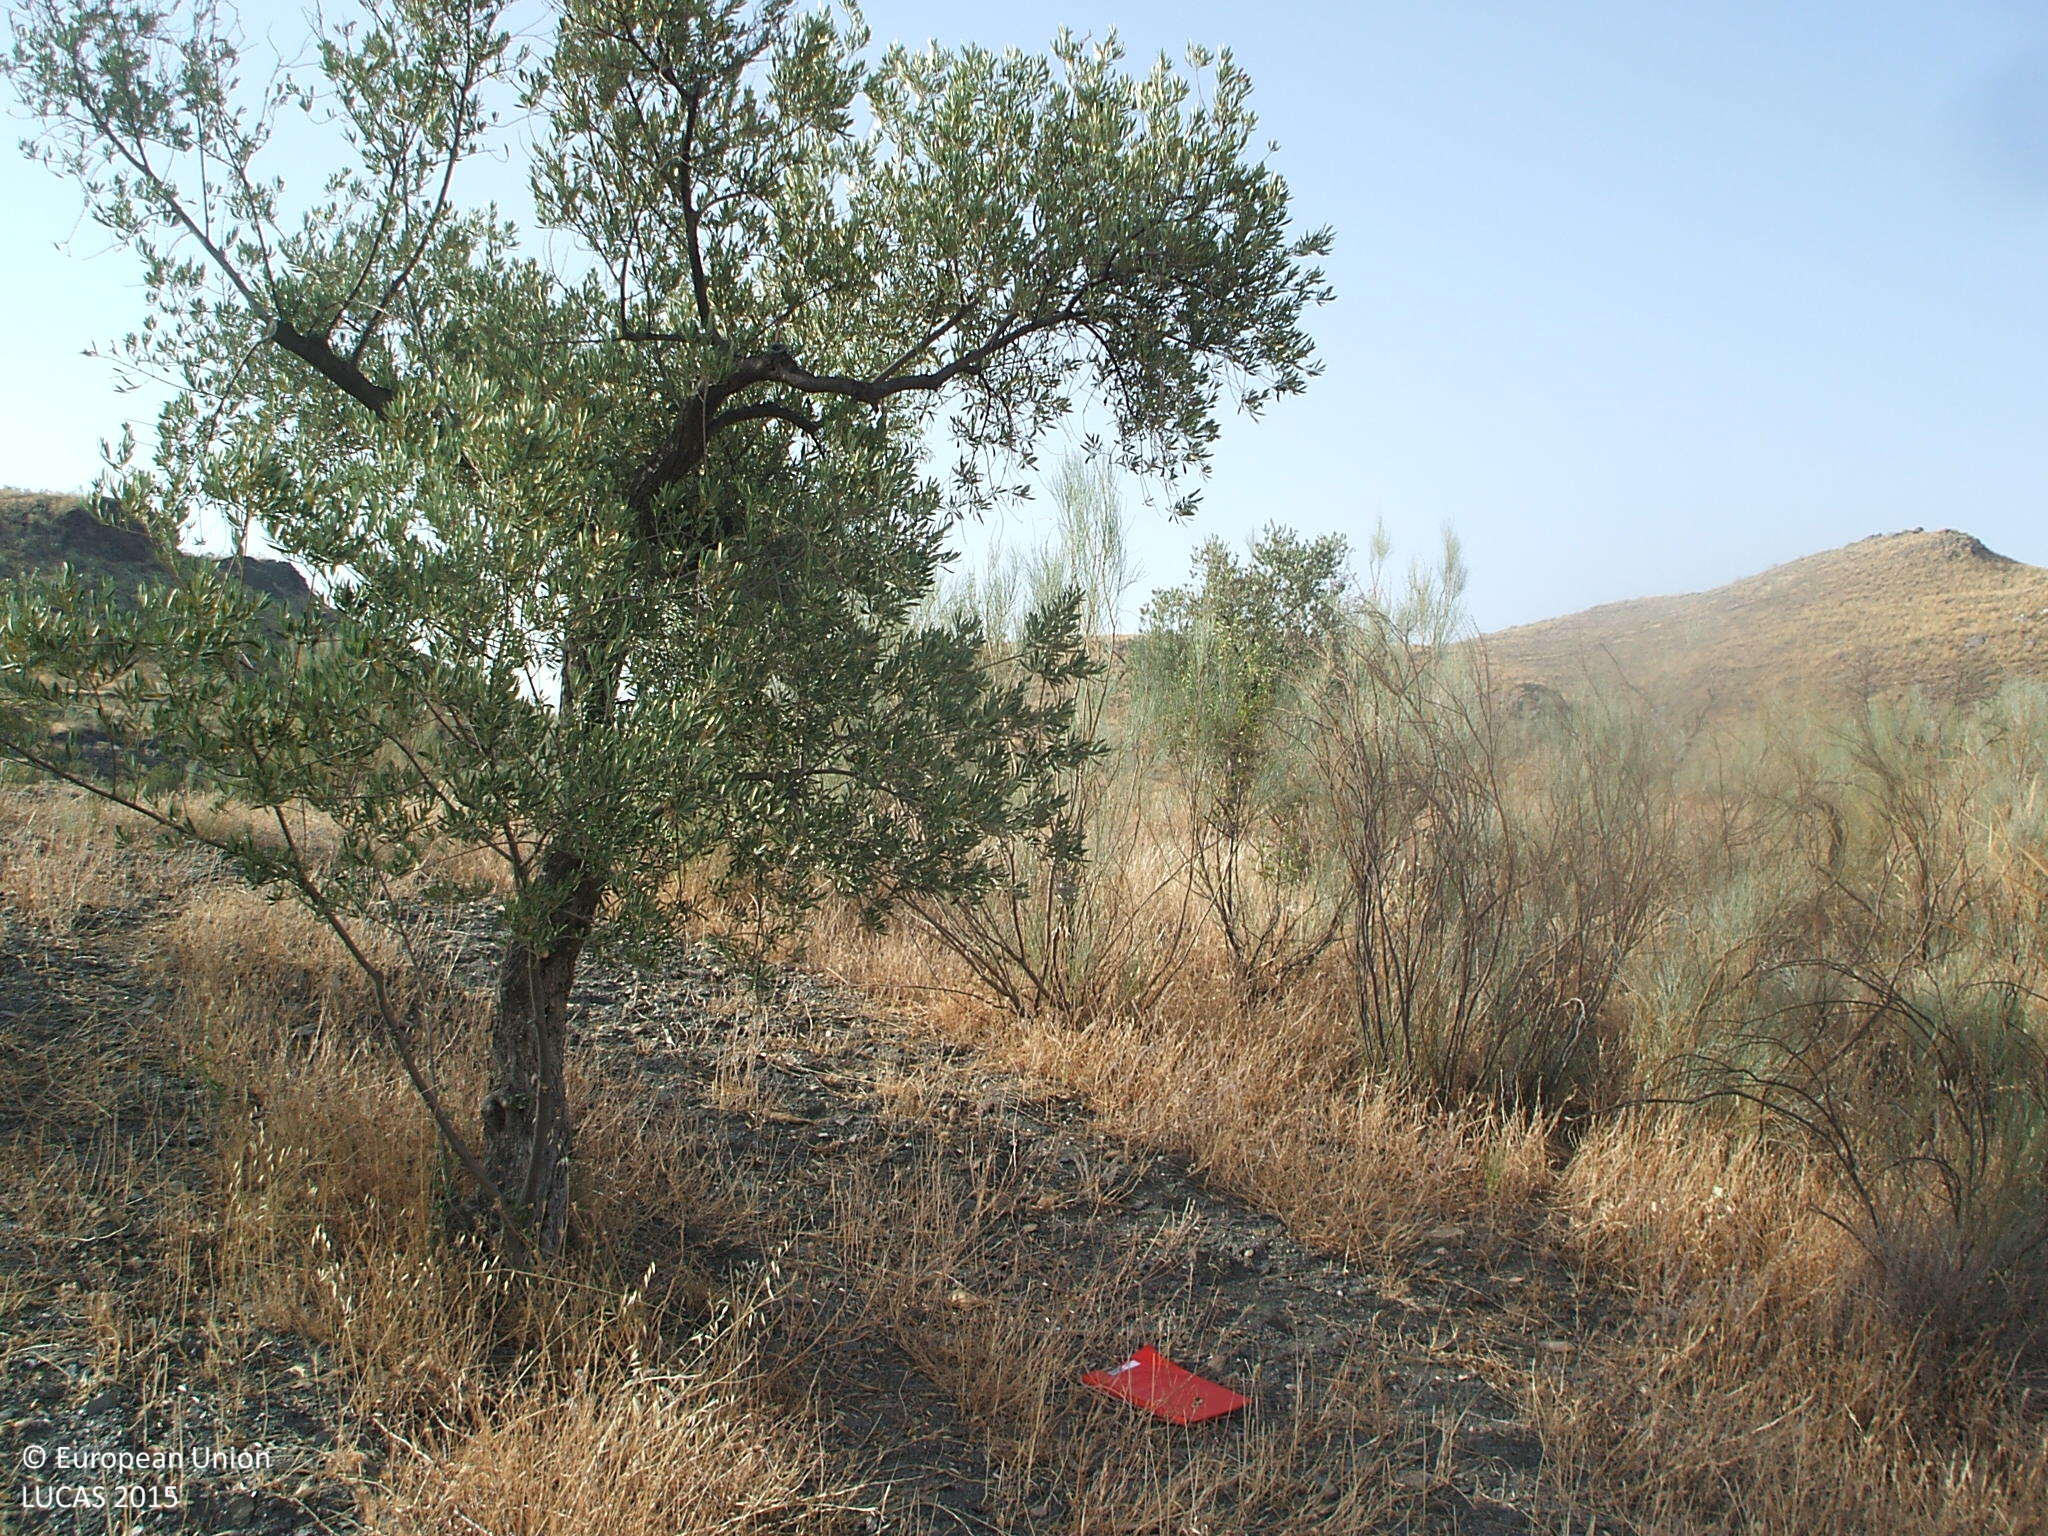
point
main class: Cropland
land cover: Olive groves
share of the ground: 10 - 25 %
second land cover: Nuts trees
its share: 10 - 25 %
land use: Agriculture (excluding fallow land and kitchen gardens)
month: July
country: ES
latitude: 37.1823
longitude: -2.3134
